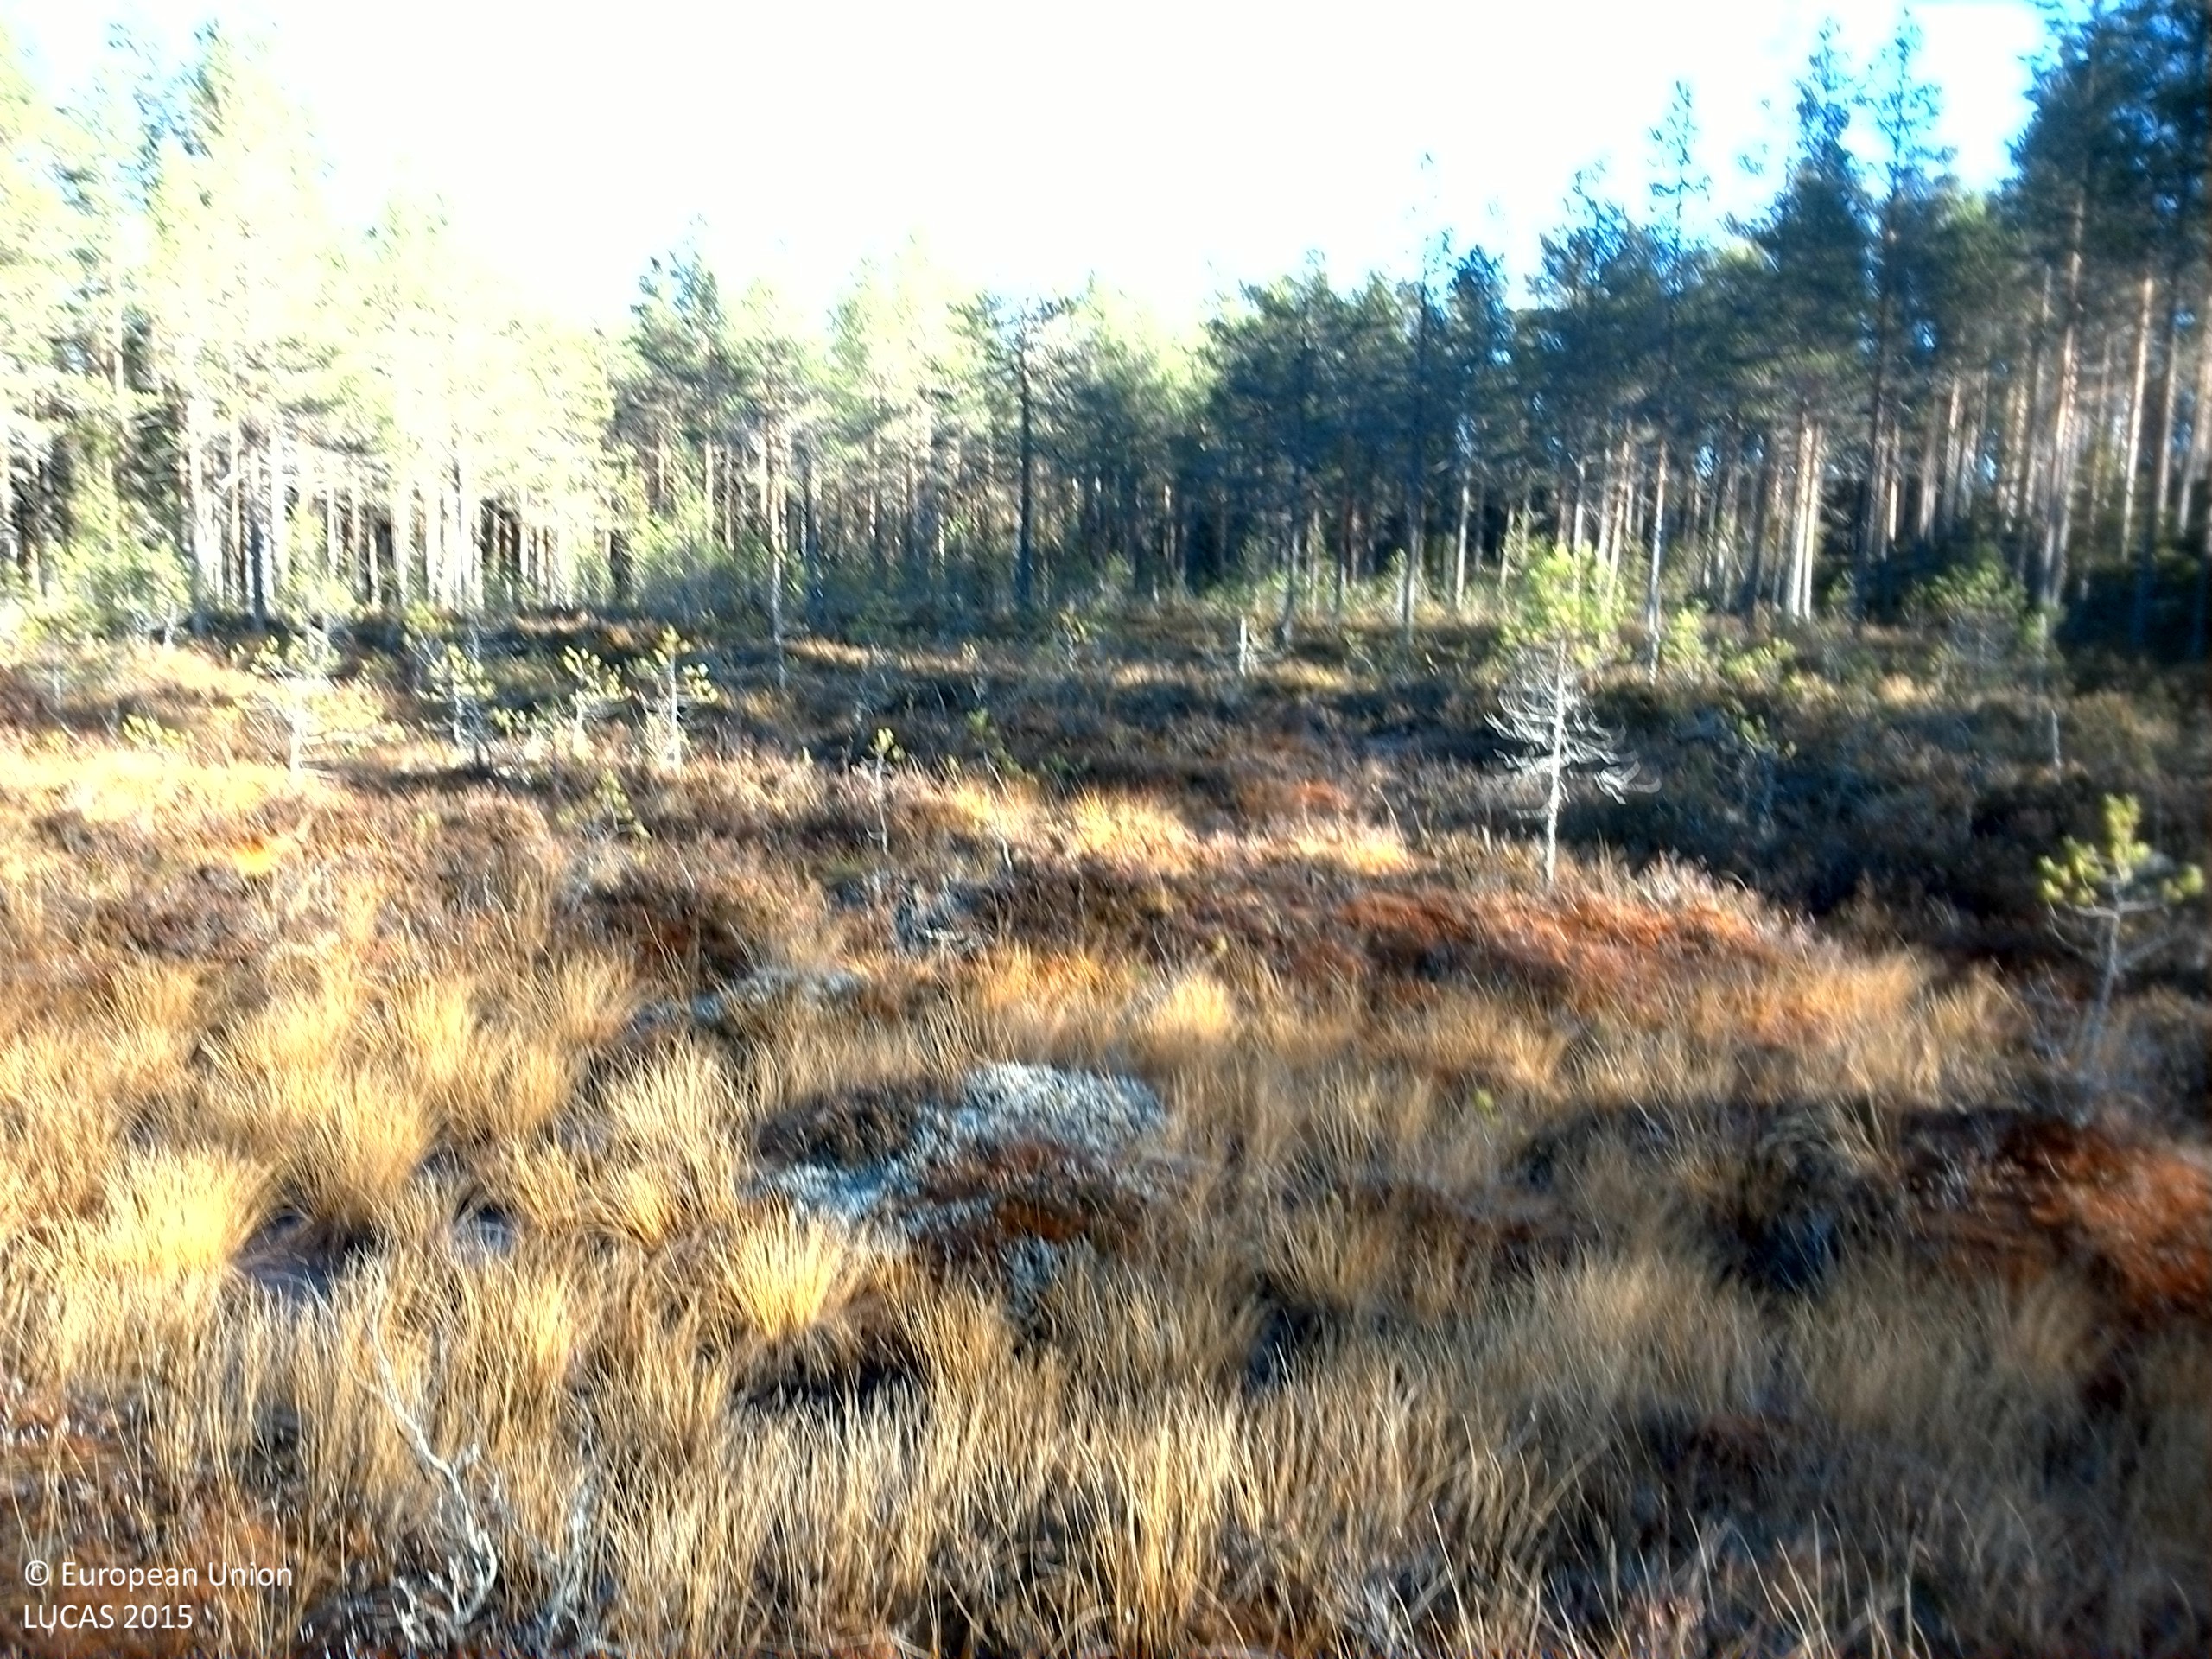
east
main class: Woodland
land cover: Pine dominated coniferous woodland
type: boreal forest
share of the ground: 10 - 25 %
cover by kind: lichens and mosses 40 %, shrubs 25 %, coniferous forest trees 20 %, herbaceous plants 15 %
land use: Semi-natural and natural areas not in use
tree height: < 5 m
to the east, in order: Pine dominated coniferous woodland
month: October
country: SE
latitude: 61.1776
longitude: 14.3561
